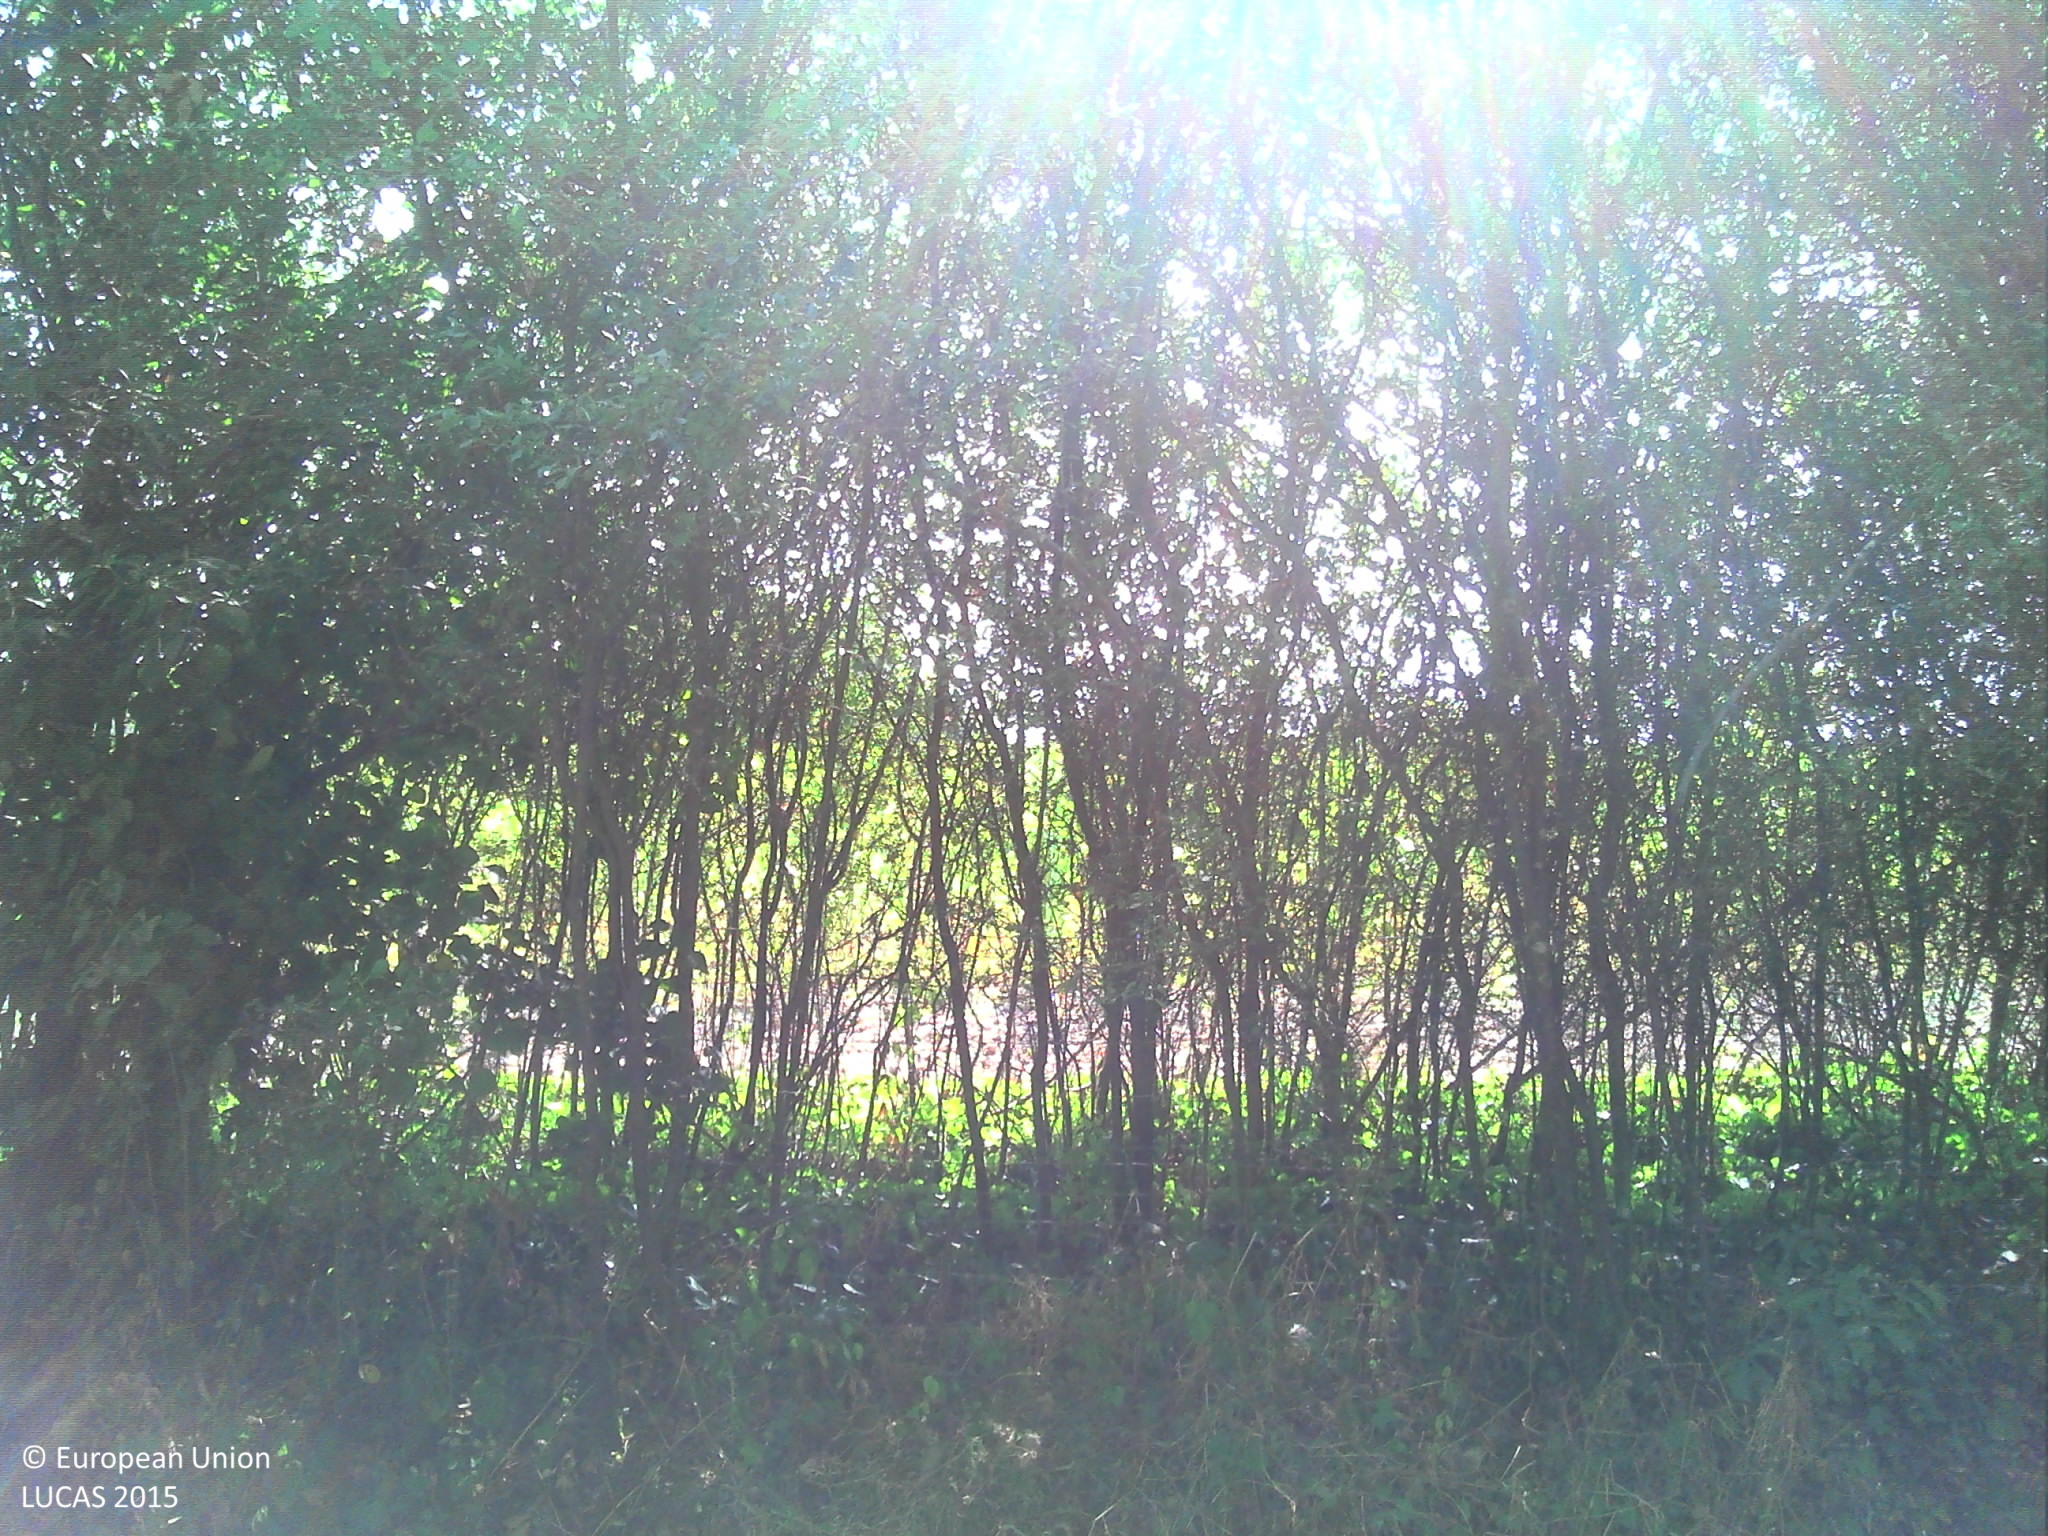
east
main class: Woodland
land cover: Pine dominated mixed woodland
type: mesophytic deciduous forest
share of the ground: > 75 %
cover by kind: broadleaved forest trees 50 %, coniferous forest trees 25 %, shrubs 10 %, herbaceous plants 10 %, lichens and mosses 5 %
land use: Forestry
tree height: > 5 m
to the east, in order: Pine dominated mixed woodland; Grass margins; Tracks; Grass margins; Ditches and canals; Fences; Abandoned hedges; Maize
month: July
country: FR
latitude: 47.0660
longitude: 0.4599
